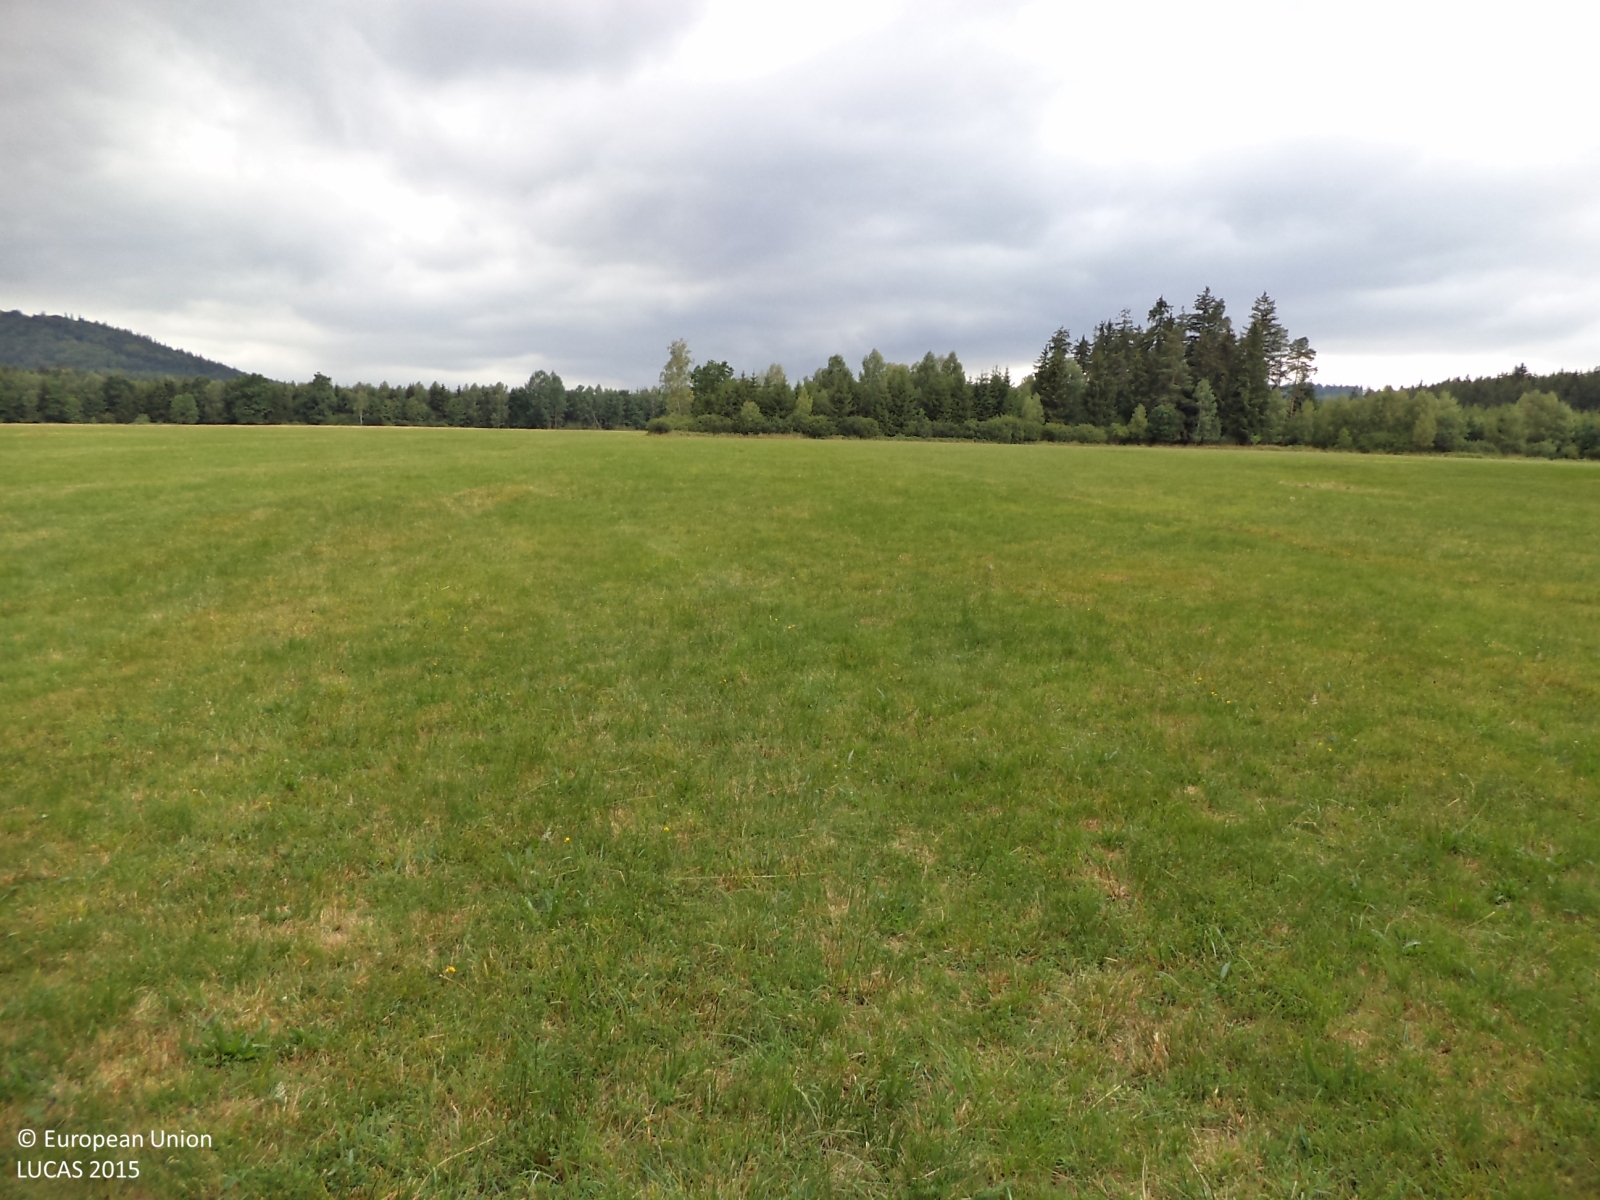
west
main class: Grassland
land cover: Grassland without tree/shrub cover
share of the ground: > 75 %
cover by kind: herbaceous plants 100 %
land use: Agriculture (excluding fallow land and kitchen gardens)
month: July
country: CZ
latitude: 49.5987
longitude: 13.8054
